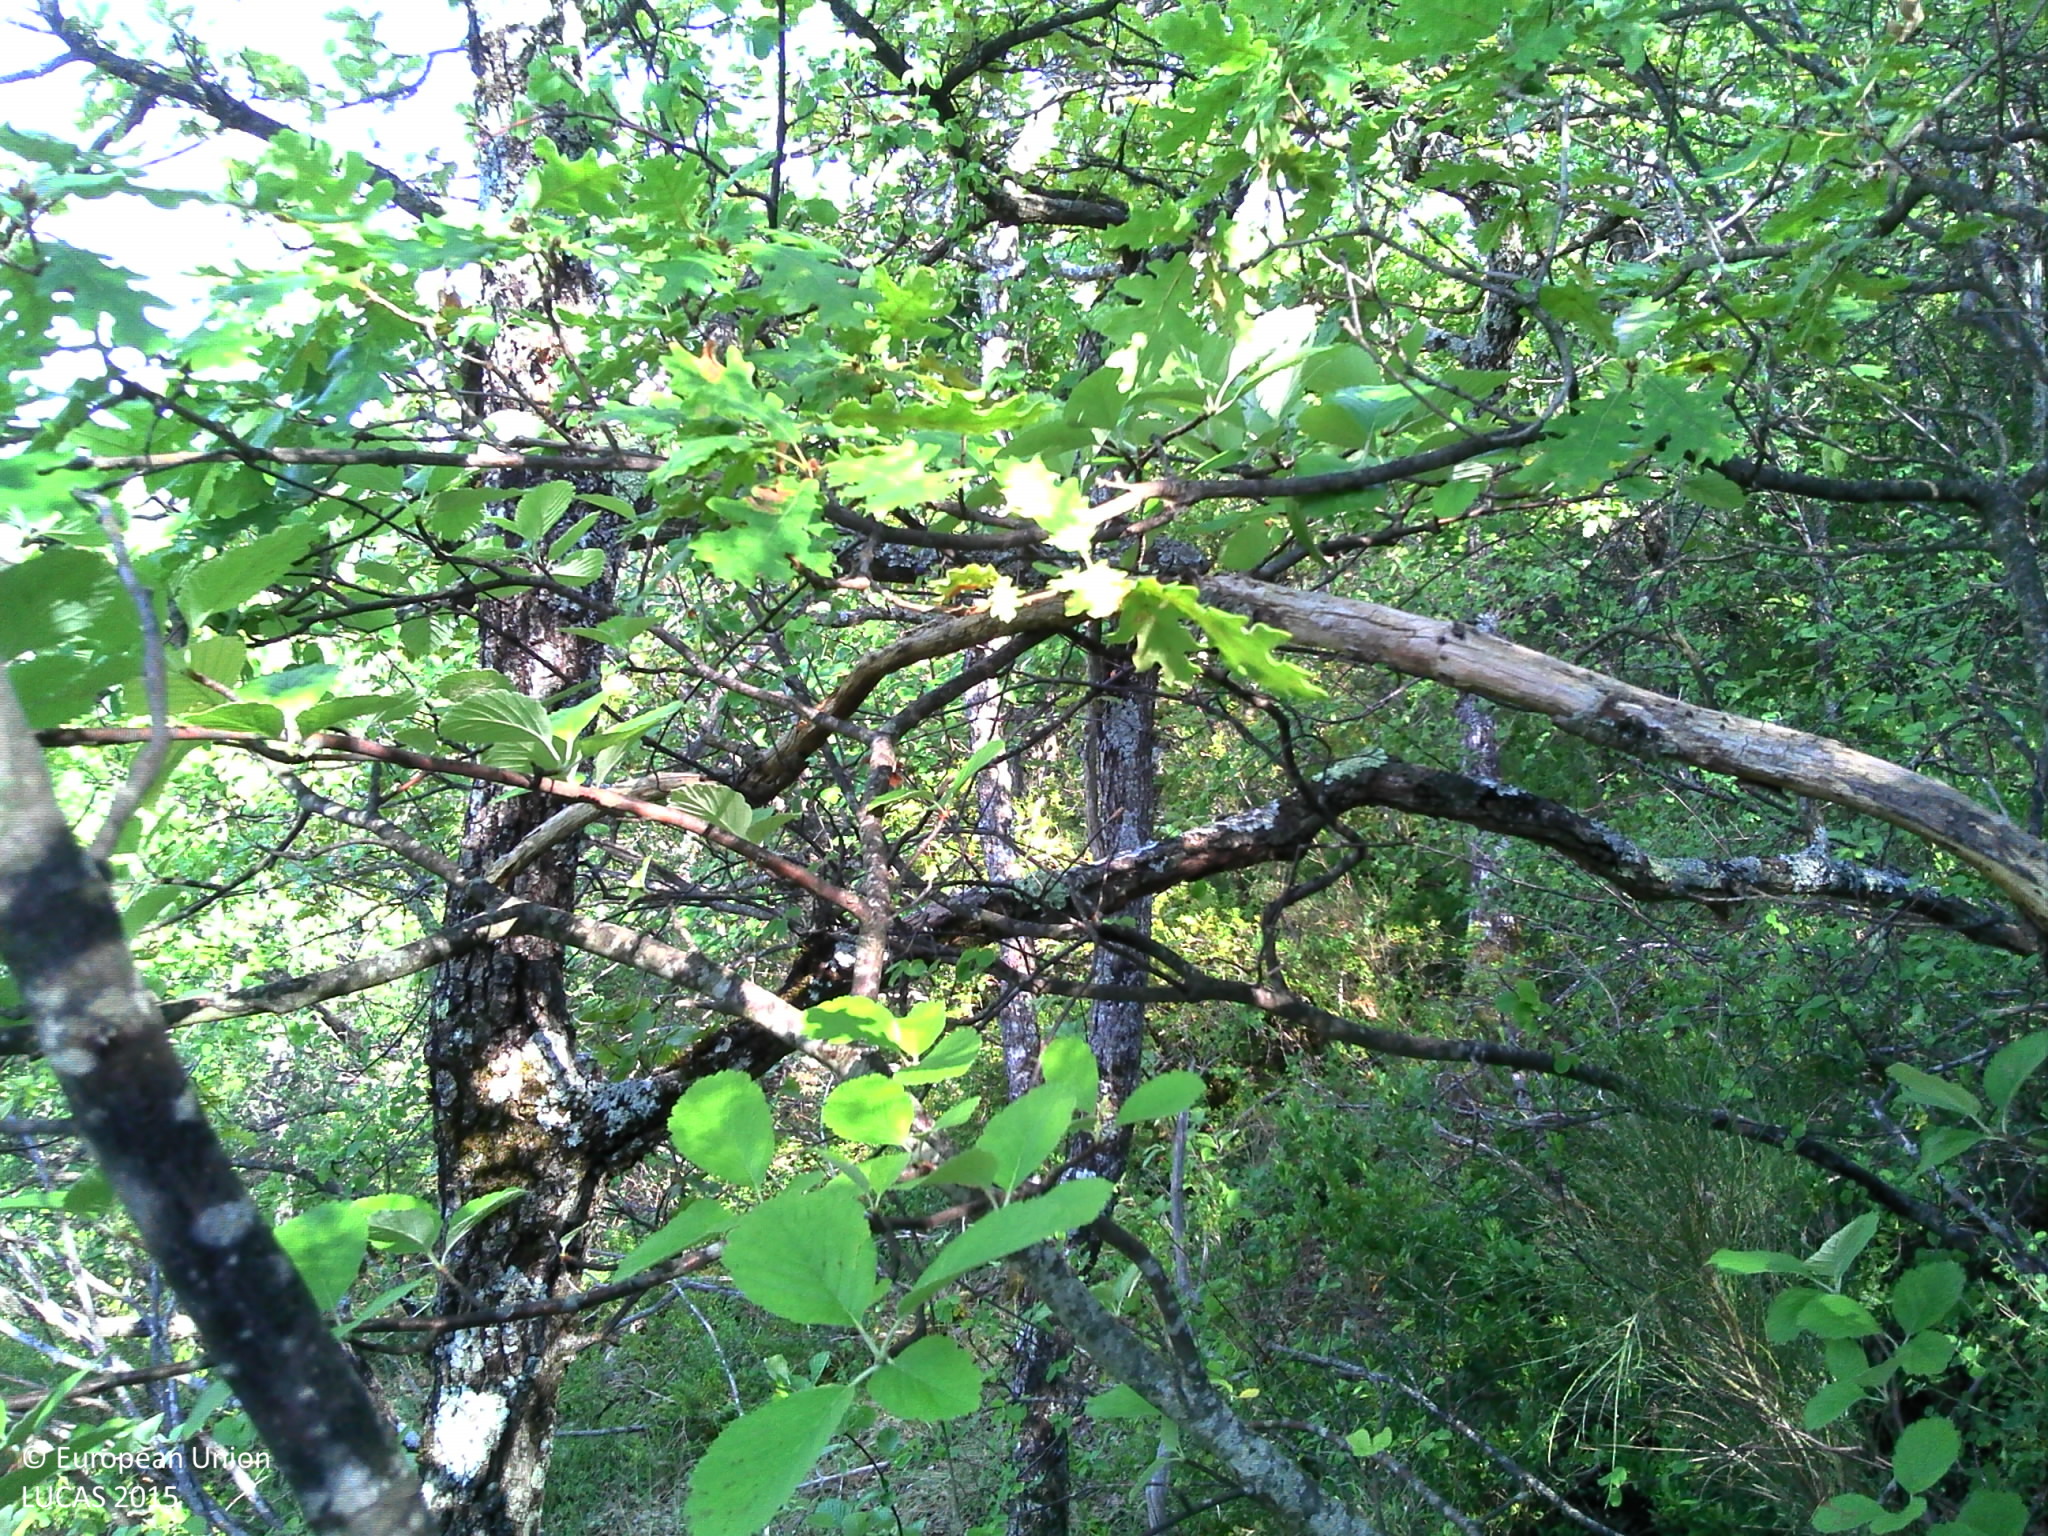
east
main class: Woodland
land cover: Broadleaved woodland
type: broadleaved evergreen forest
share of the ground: > 75 %
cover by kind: broadleaved forest trees 75 %, shrubs 15 %, herbaceous plants 5 %, unconsolidated bare surface 5 %
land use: Semi-natural and natural areas not in use
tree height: < 5 m
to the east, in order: Broadleaved woodland
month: August
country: FR
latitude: 43.8497
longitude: 5.3688
